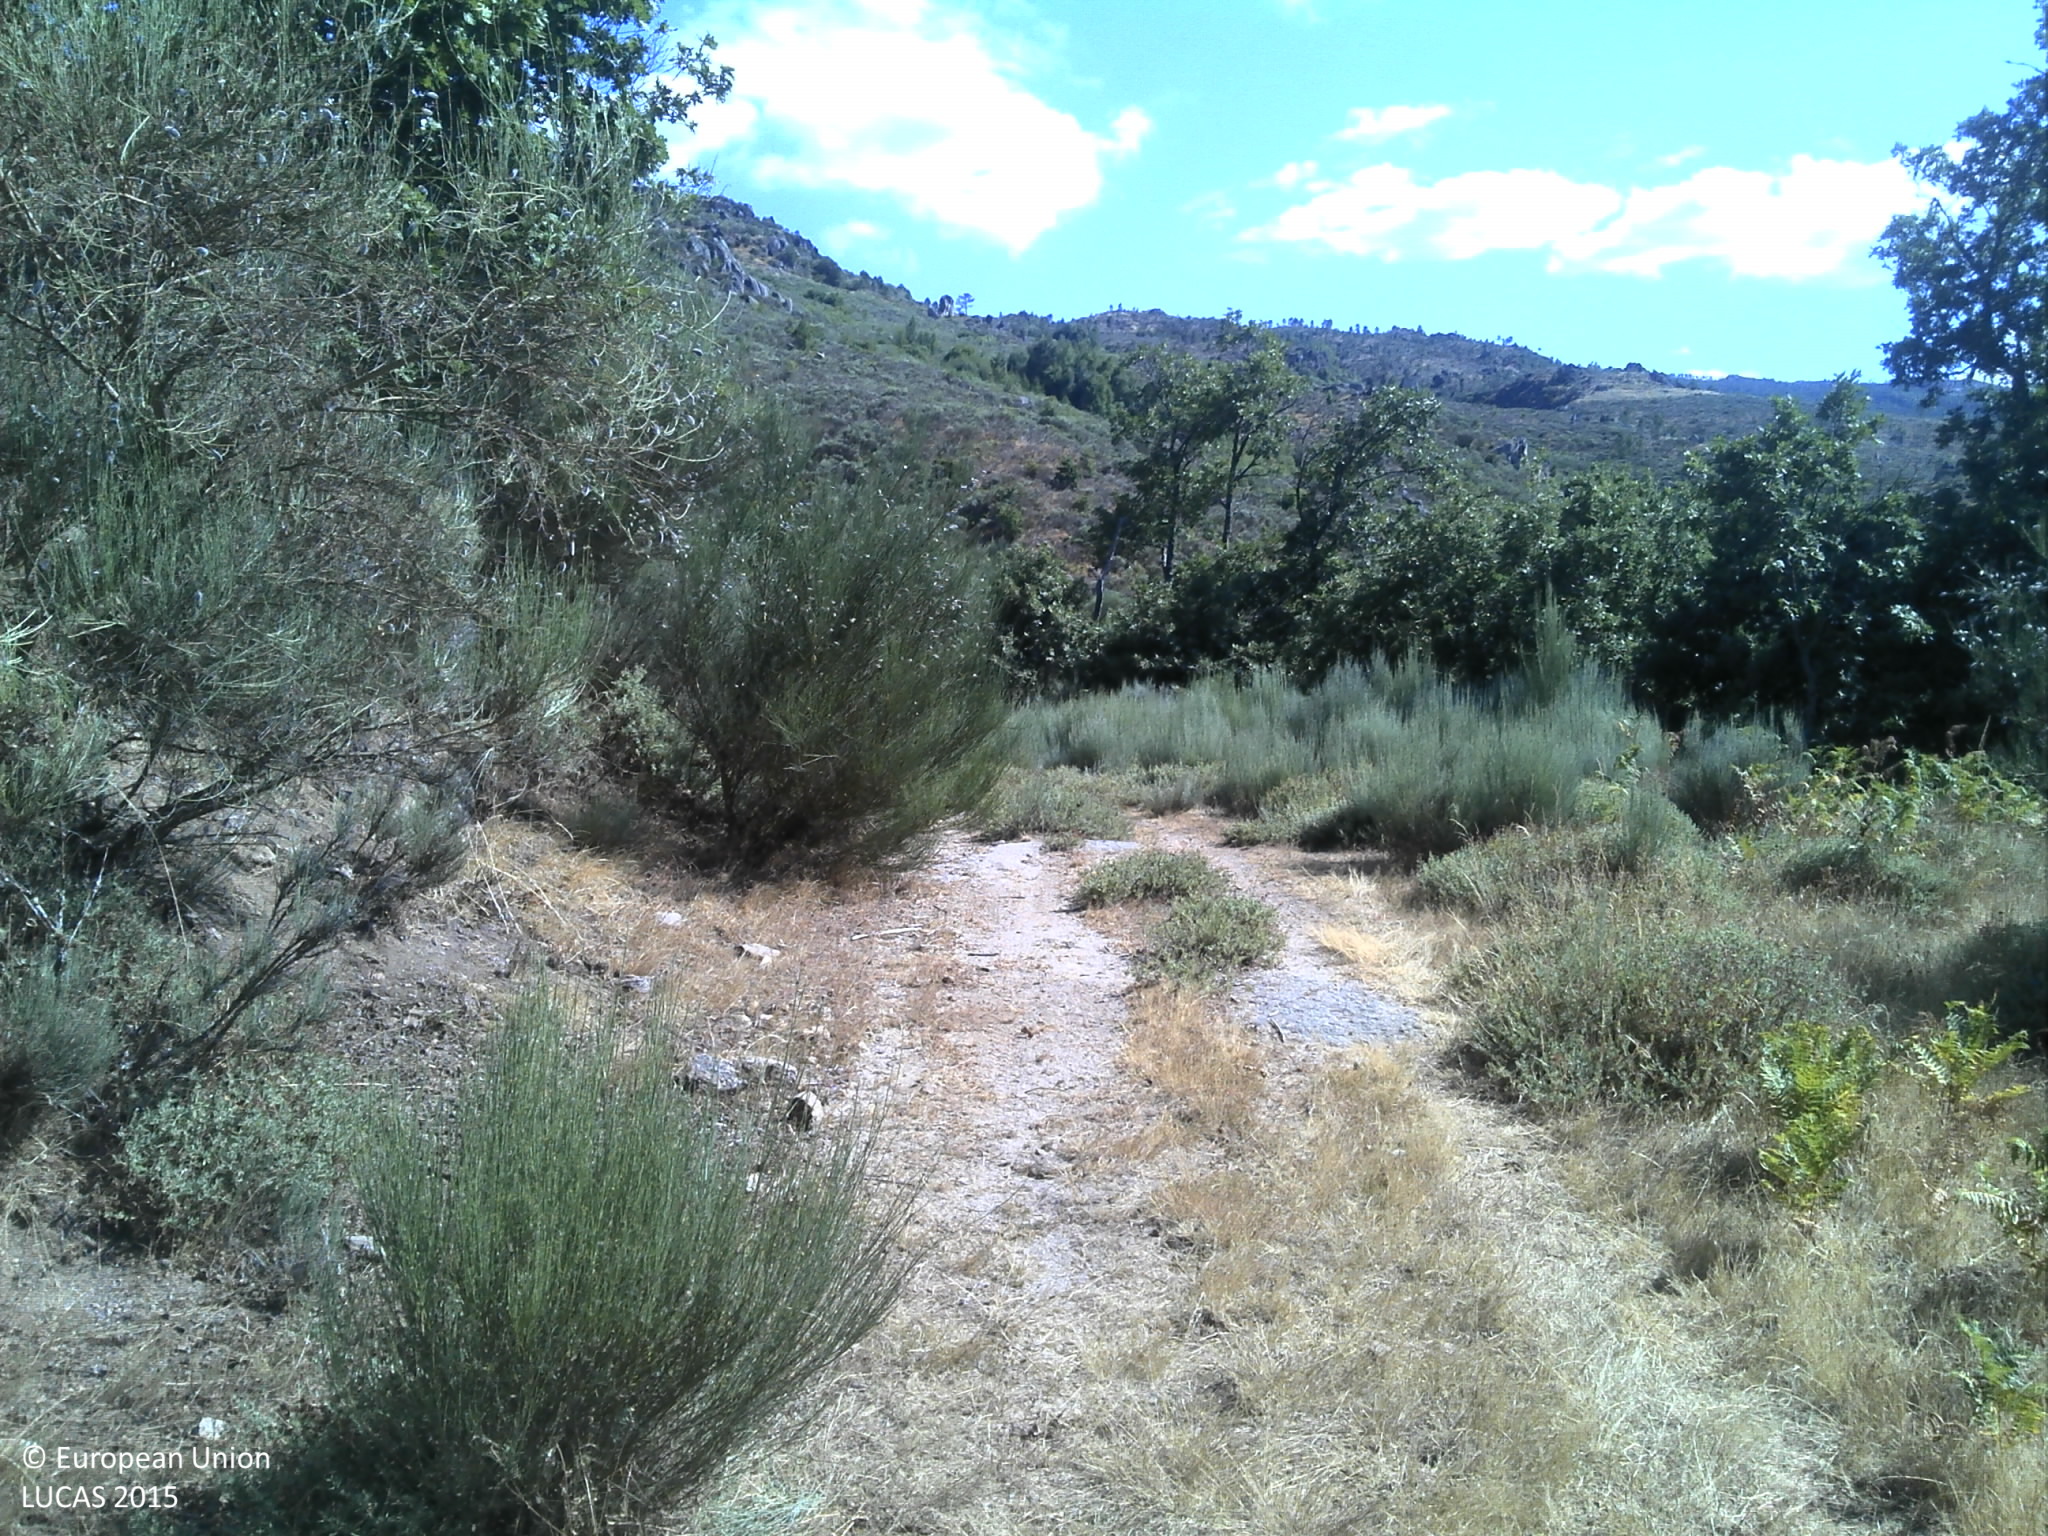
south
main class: Shrubland
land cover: Shrubland without tree cover
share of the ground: 25 - 50 %
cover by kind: shrubs 45 %, unconsolidated bare surface 30 %, herbaceous plants 15 %
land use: Semi-natural and natural areas not in use
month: August
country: PT
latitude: 40.5088
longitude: -7.4943
